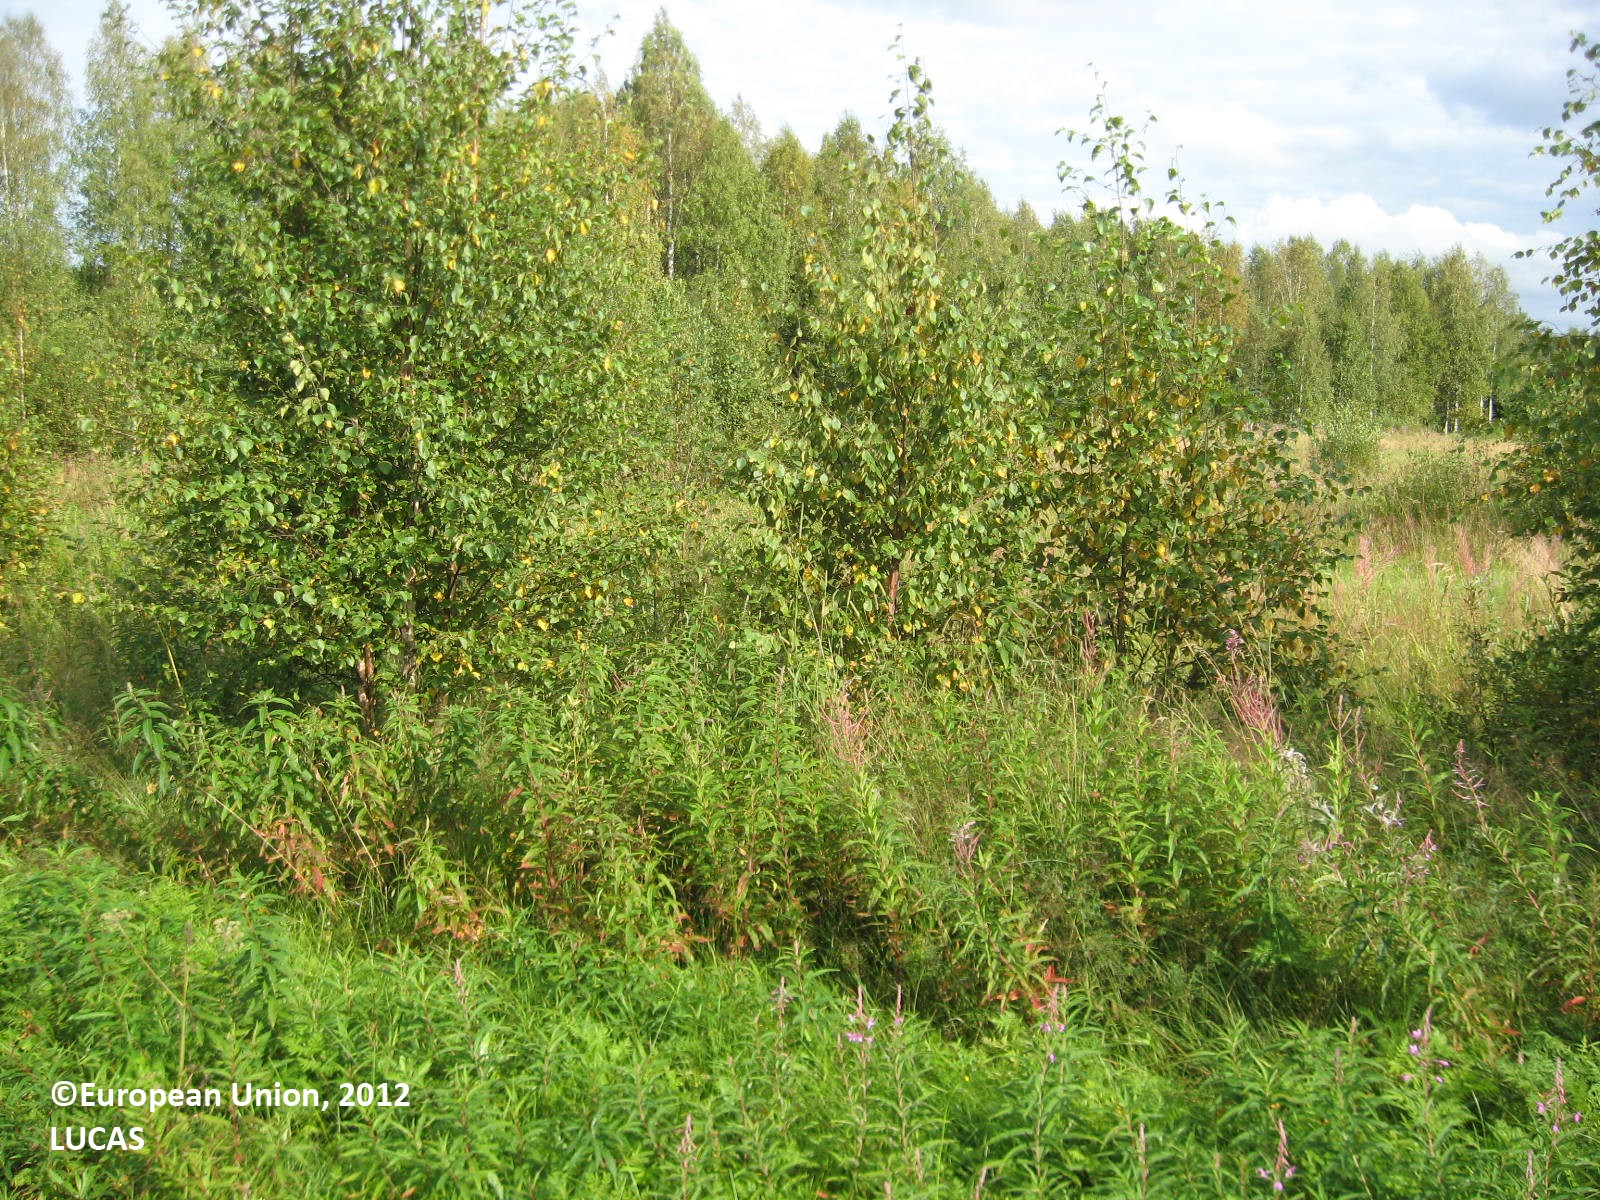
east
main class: Cropland
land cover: Temporary grasslands
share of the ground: > 75 %
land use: Agriculture (excluding fallow land and kitchen gardens)
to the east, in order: Temporary grasslands; Shruby margins; Temporary grasslands; Shruby margins; Temporary grasslands; Ditches and canals; Temporary grasslands; Other mixed woodland; Ditches and canals; Other mixed woodland; Ditches and canals; Other mixed woodland; Ditches and canals; Grass margins; Paved roads, cycling and walking lanes; Grass margins; Ditches and canals; Grassland with sparse tree/shrub cover
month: August
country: FI
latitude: 63.3614
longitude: 30.0218
